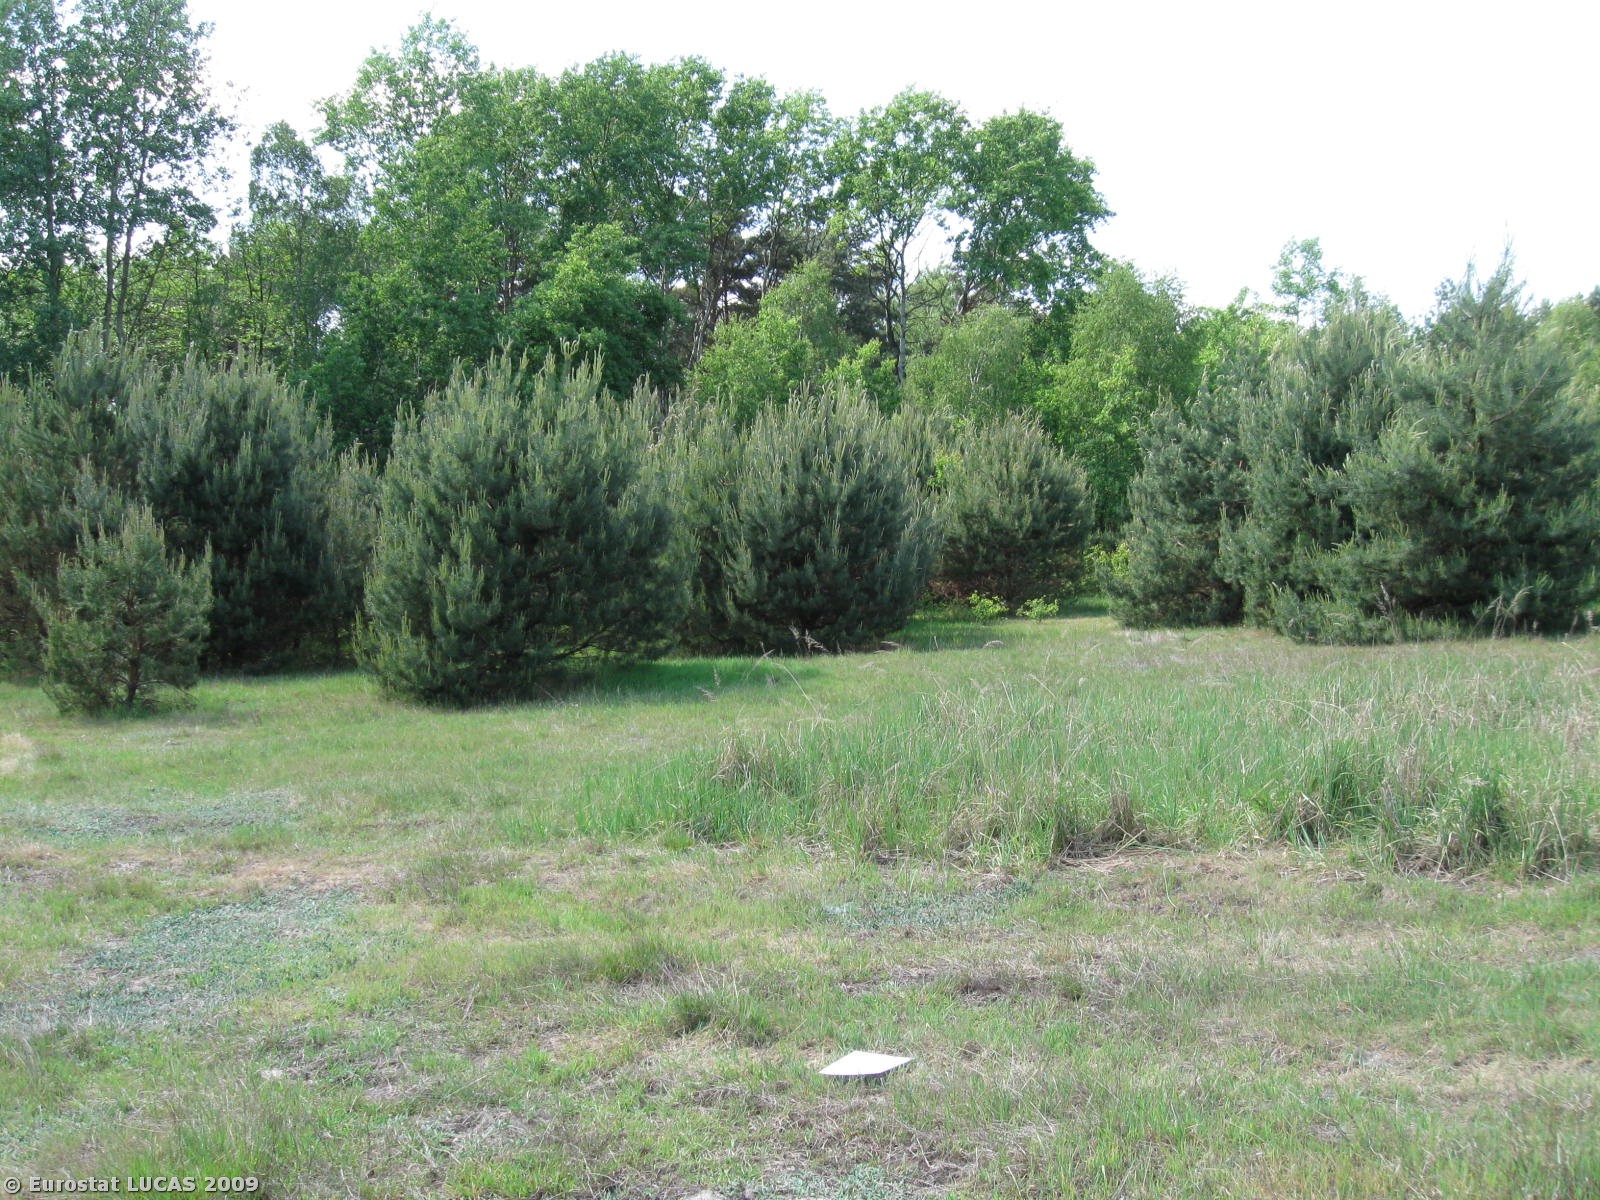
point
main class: Grassland
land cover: Grassland without tree/shrub cover
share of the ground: > 75 %
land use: Unused
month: May
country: PL
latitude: 50.6701
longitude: 20.3800
